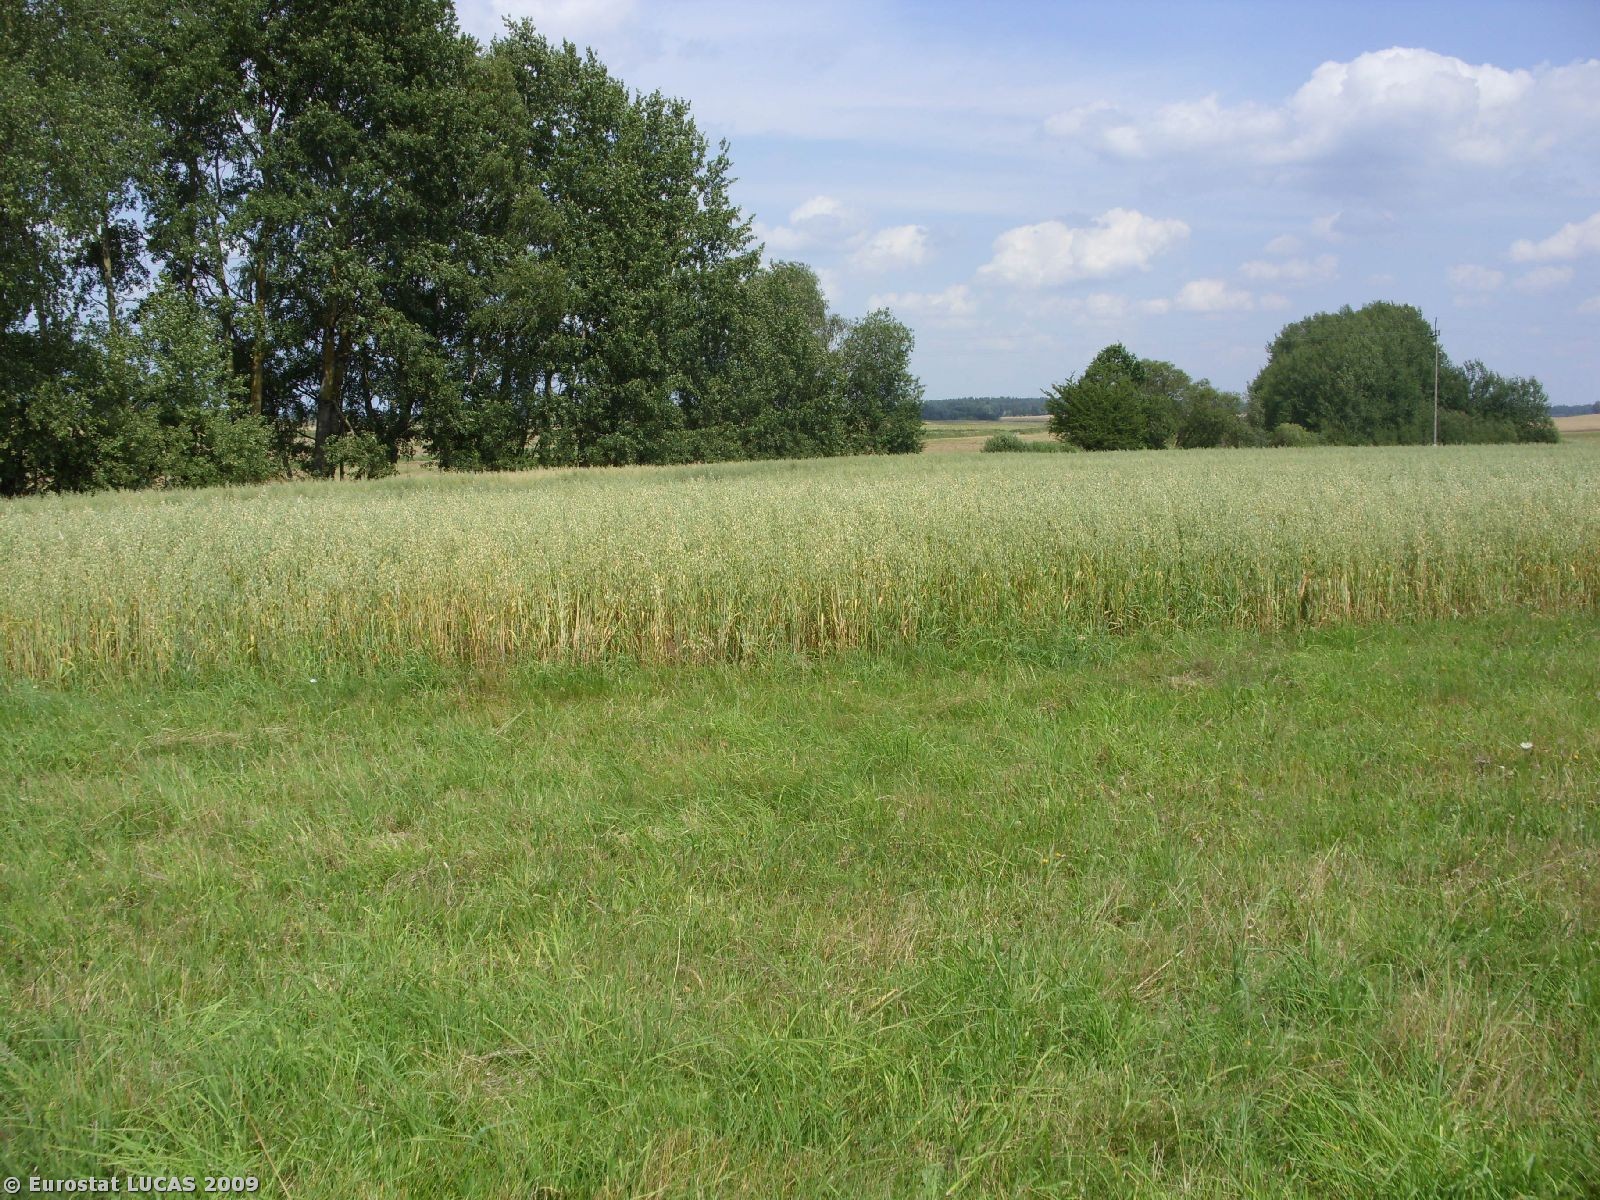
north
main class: Woodland
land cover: Broadleaved woodland
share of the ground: > 75 %
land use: Unused
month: July
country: PL
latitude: 53.9973
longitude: 15.5099
